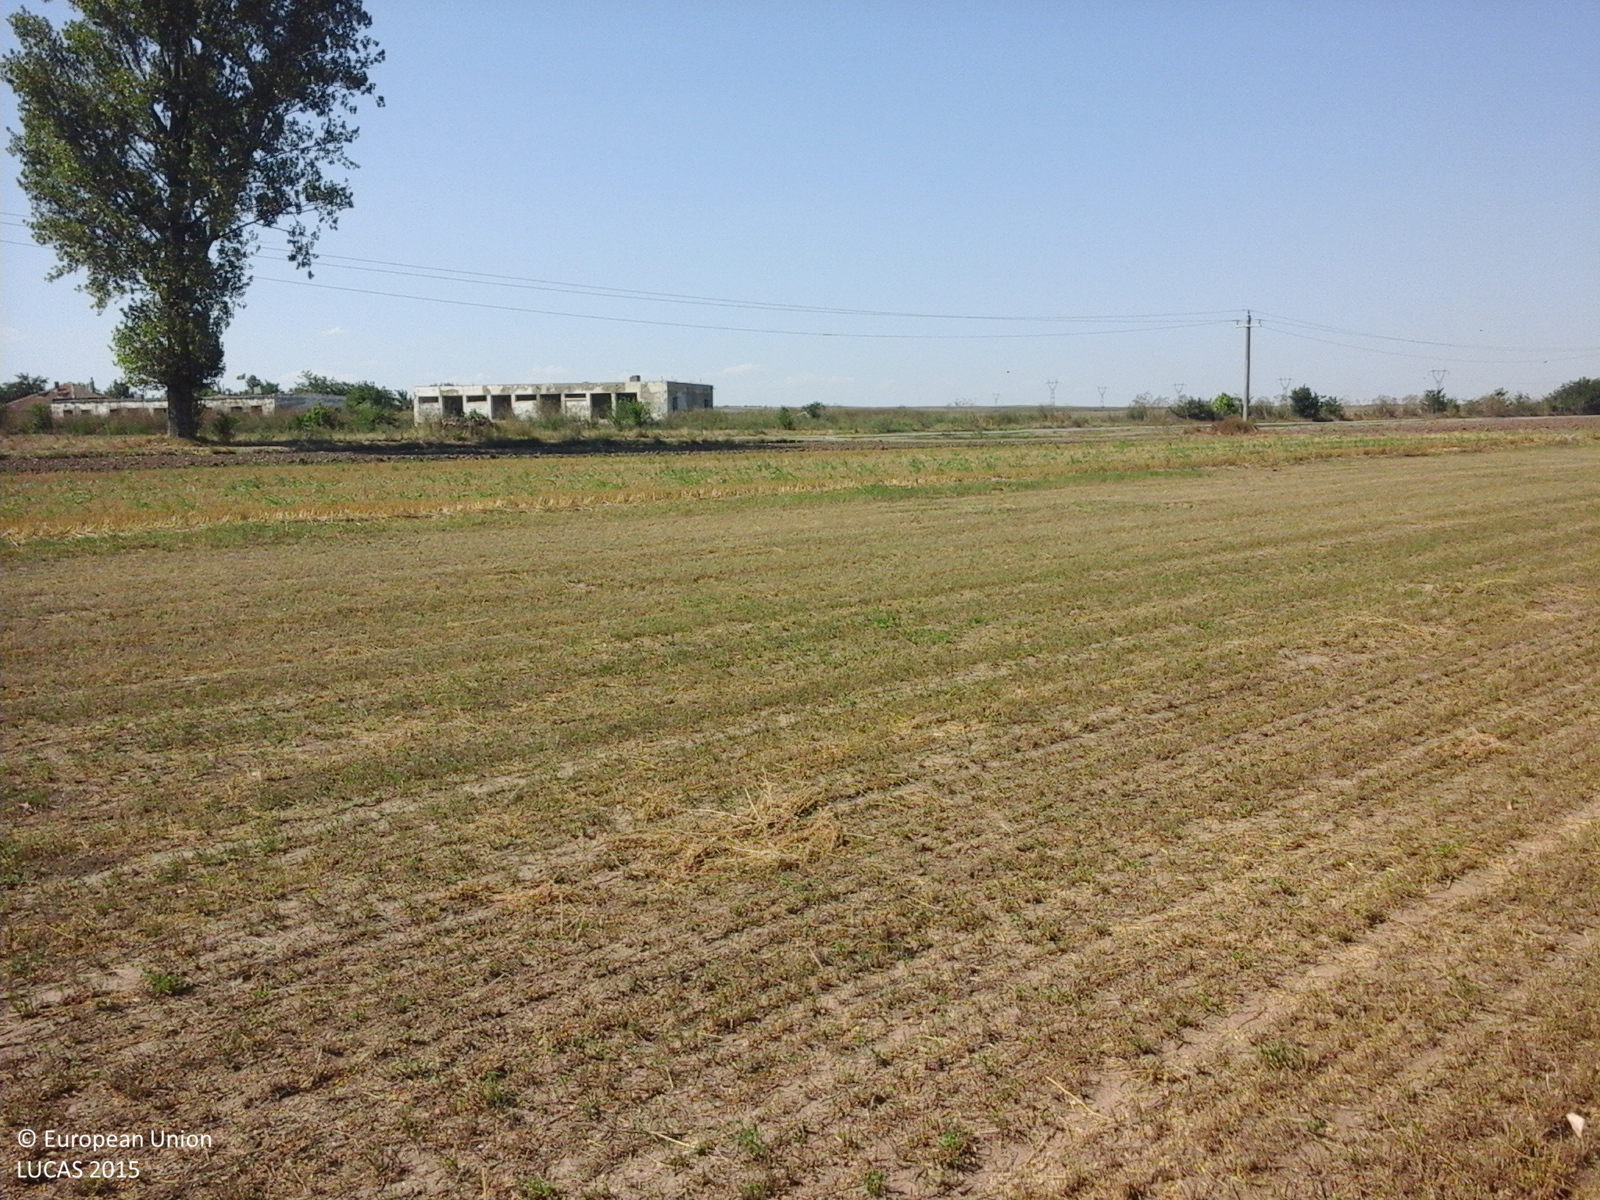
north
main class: Cropland
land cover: Lucerne
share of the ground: 10 - 25 %
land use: Agriculture (excluding fallow land and kitchen gardens)
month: August
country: RO
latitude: 44.2673
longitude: 28.3429
